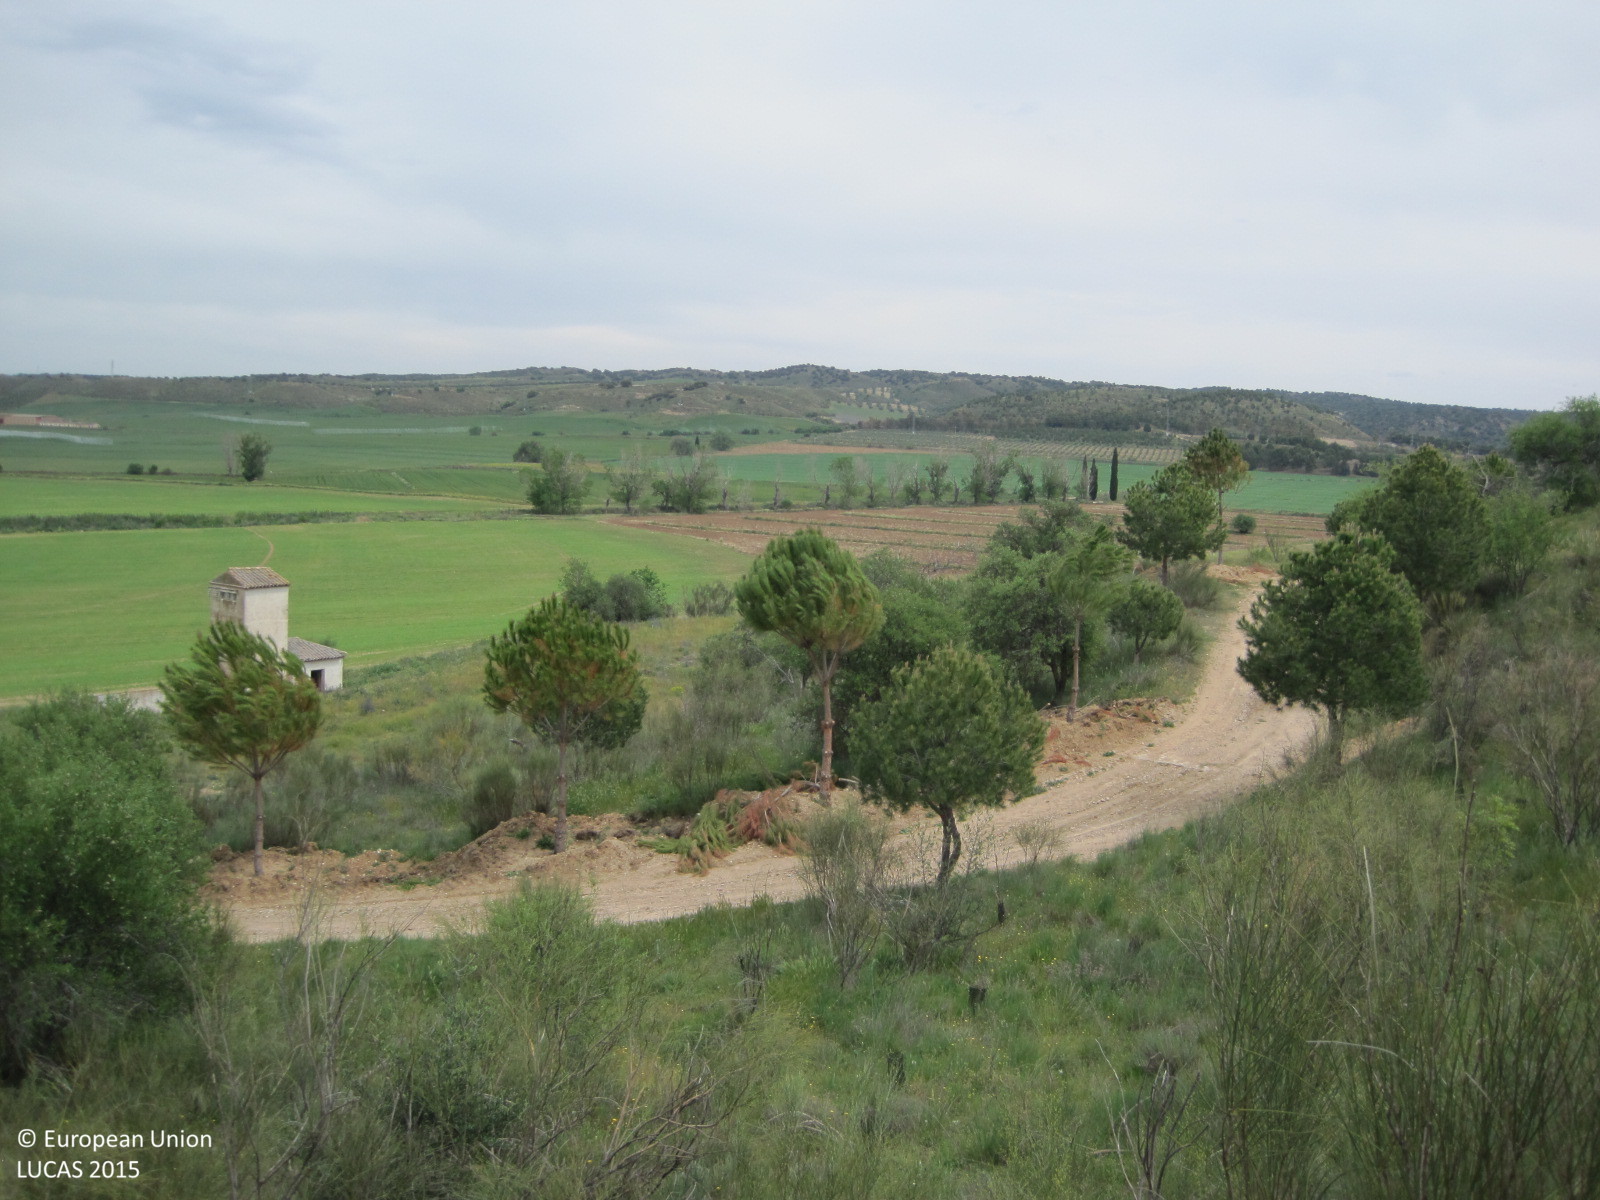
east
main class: Shrubland
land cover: Shrubland without tree cover
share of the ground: > 75 %
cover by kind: shrubs 100 %
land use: Semi-natural and natural areas not in use
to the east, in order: Shrubland without tree cover; Lines of trees; Tracks; Lines of trees; Shrubland with sparse tree cover; Grassland without tree/shrub cover; Shrubland with sparse tree cover; Spontaneously vegetated surfaces; Grass margins; Ditches and canals; Grass margins; Spontaneously vegetated surfaces; Grass margins; Other bare soil
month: April
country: ES
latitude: 39.8501
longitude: -4.2141
